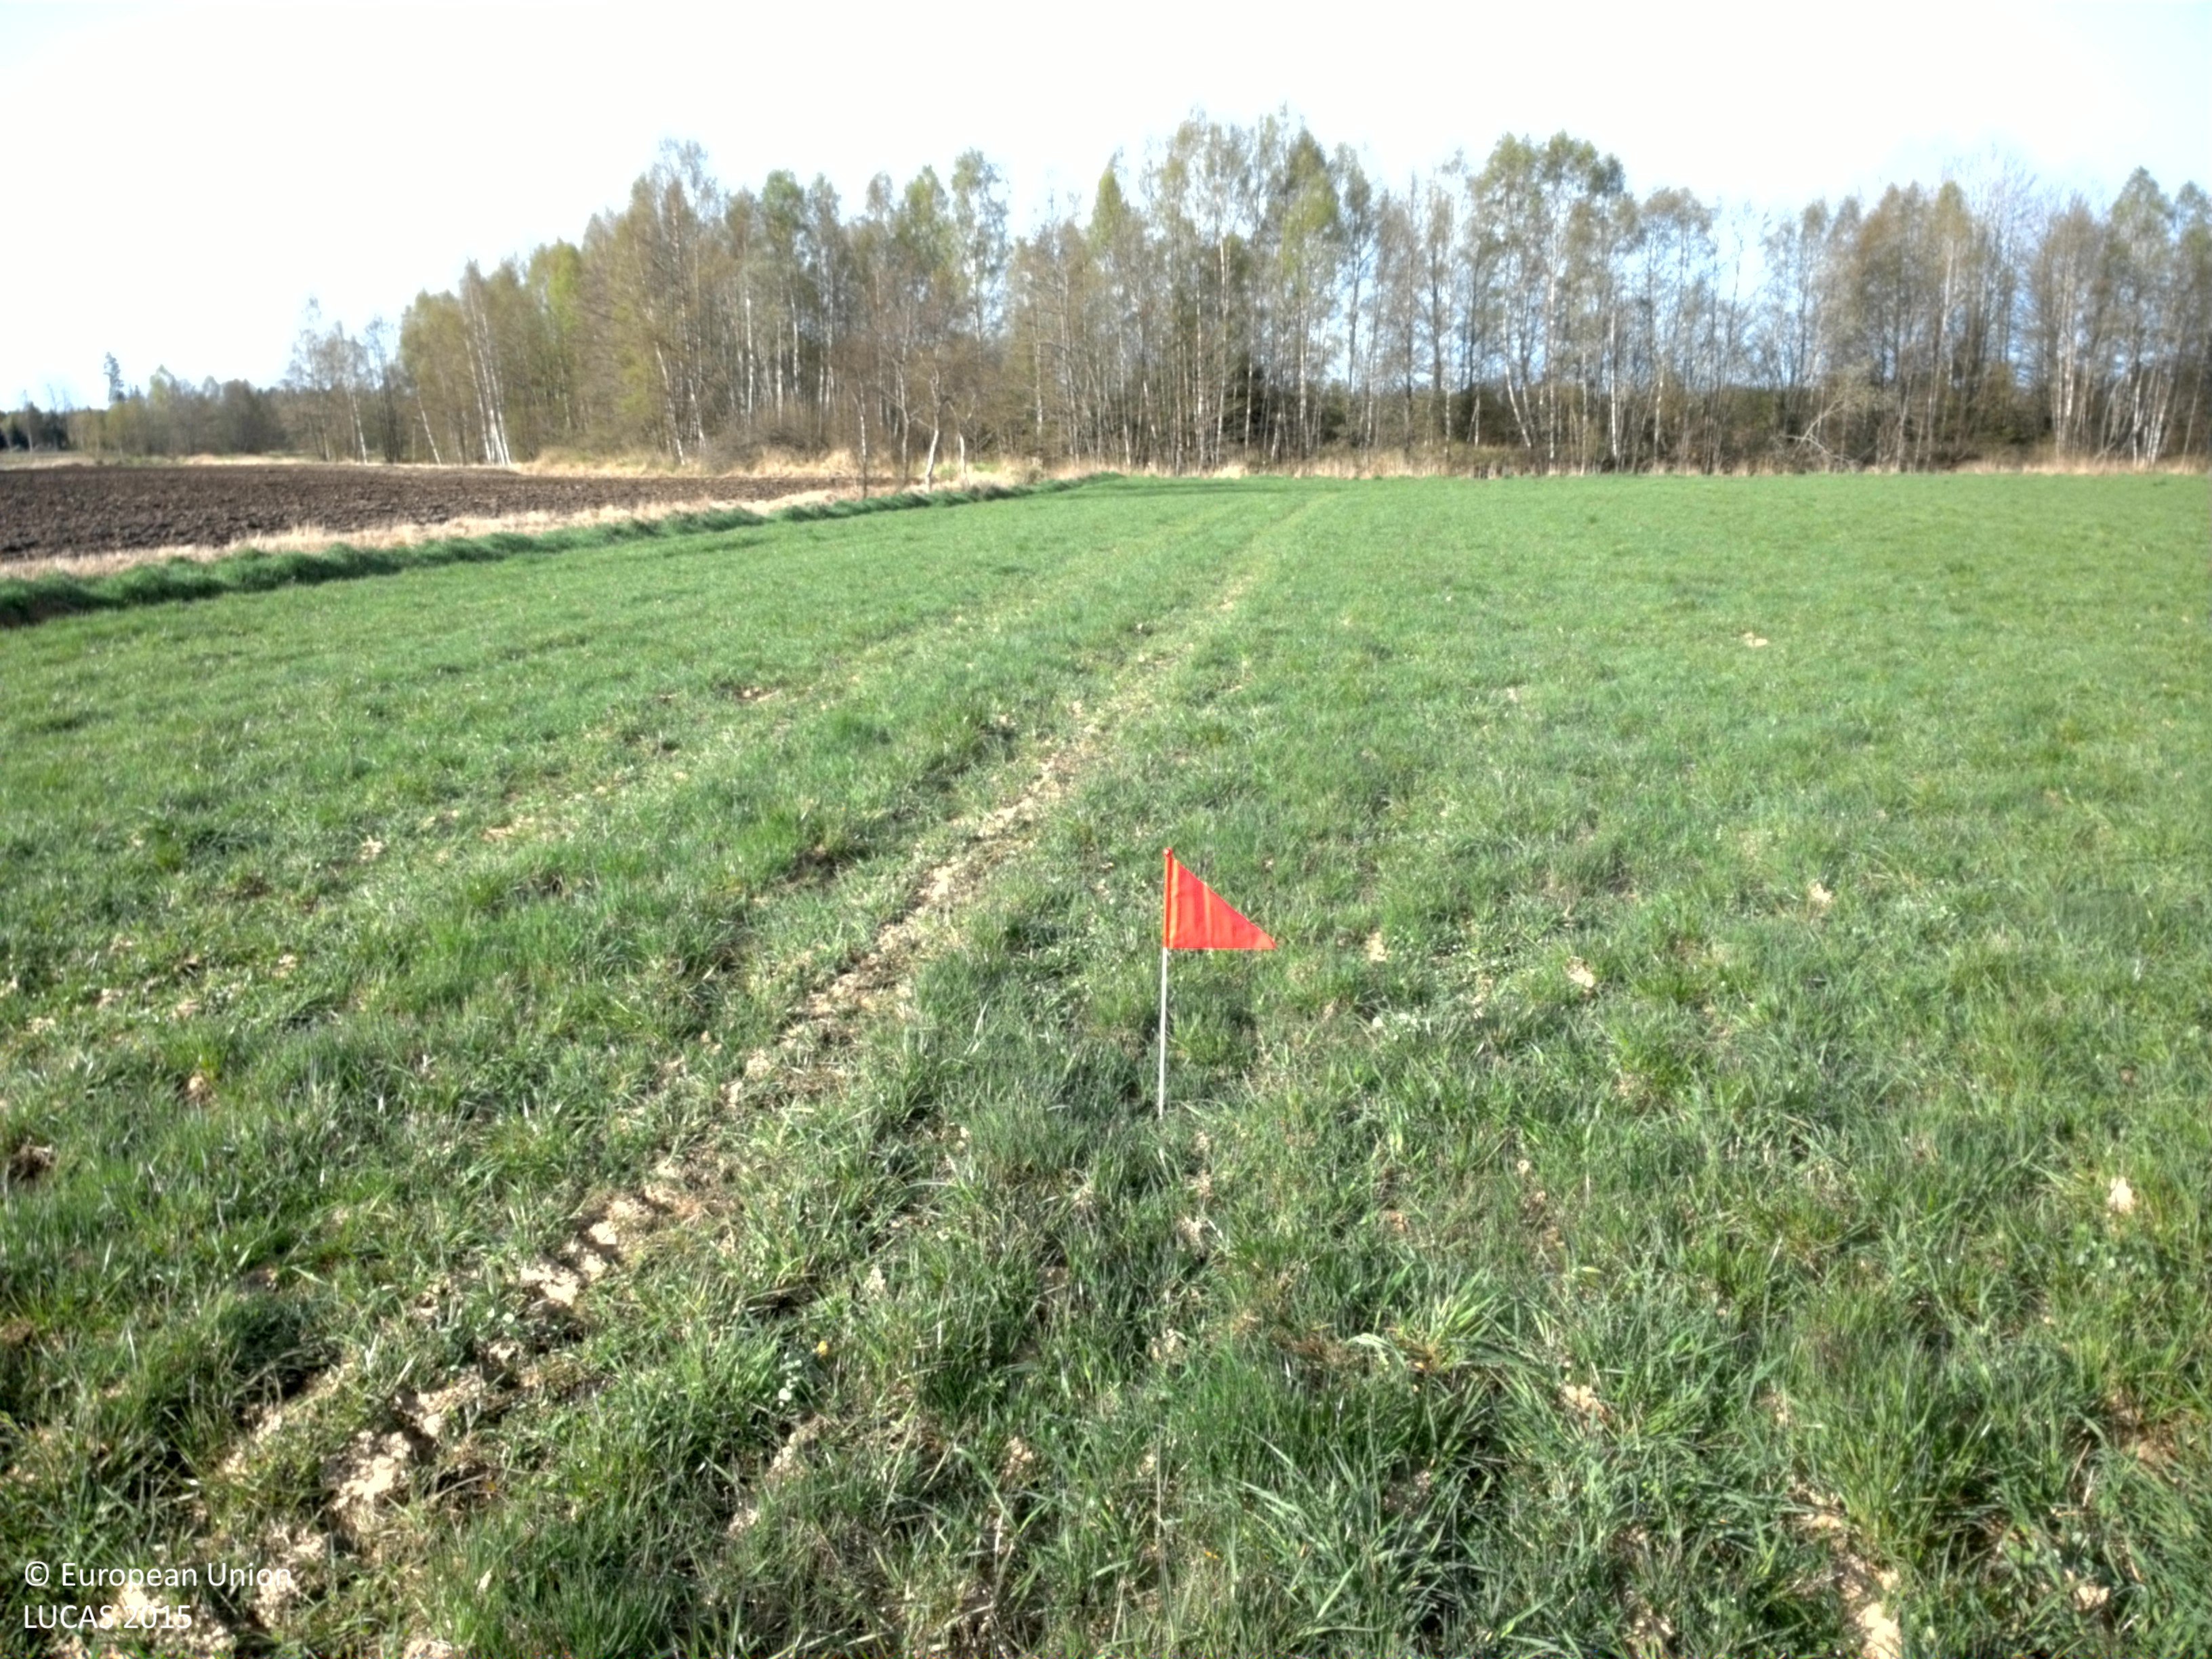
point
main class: Grassland
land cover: Grassland without tree/shrub cover
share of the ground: > 75 %
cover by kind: herbaceous plants 100 %
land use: Agriculture (excluding fallow land and kitchen gardens)
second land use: Amenities, museums, leisure
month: May
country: SE
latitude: 56.7624
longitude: 14.8559
